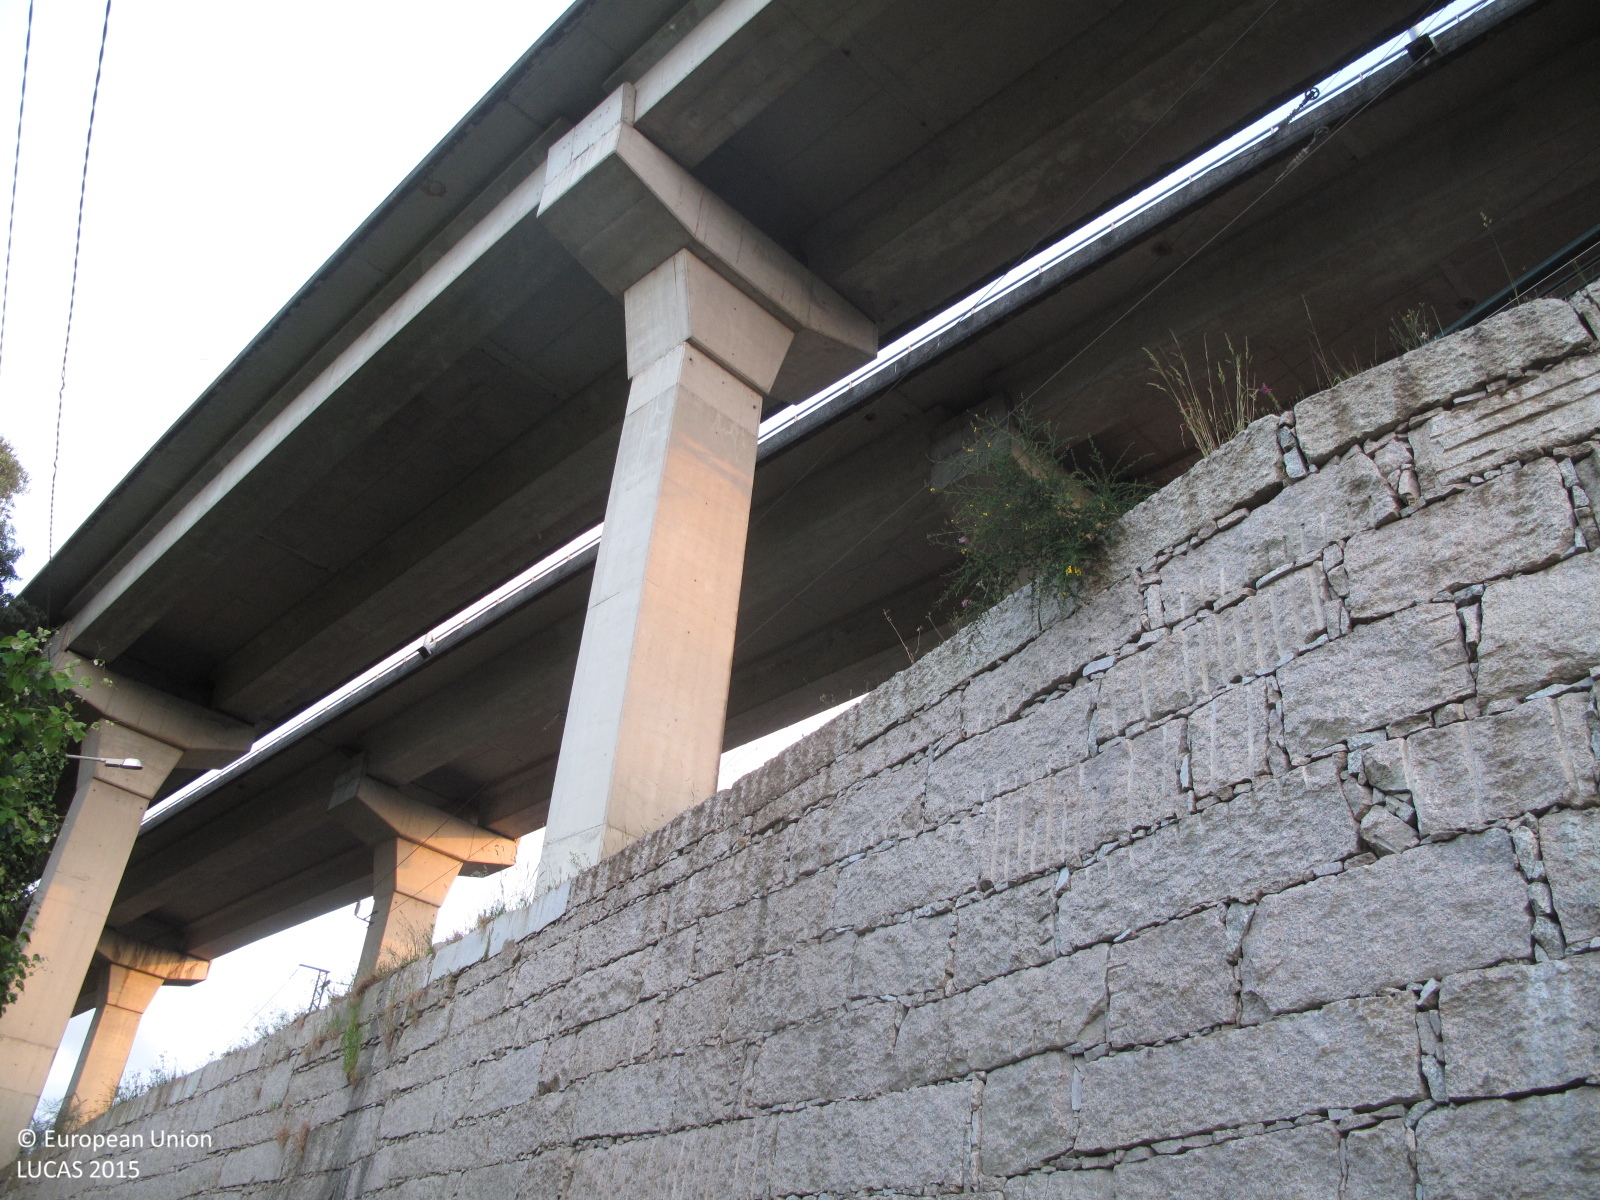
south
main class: Cropland
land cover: Other citrus fruit
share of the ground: 25 - 50 %
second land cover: Spontaneously vegetated surfaces
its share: 25 - 50 %
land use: Kitchen garden
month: June
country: ES
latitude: 42.8630
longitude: -8.5498
